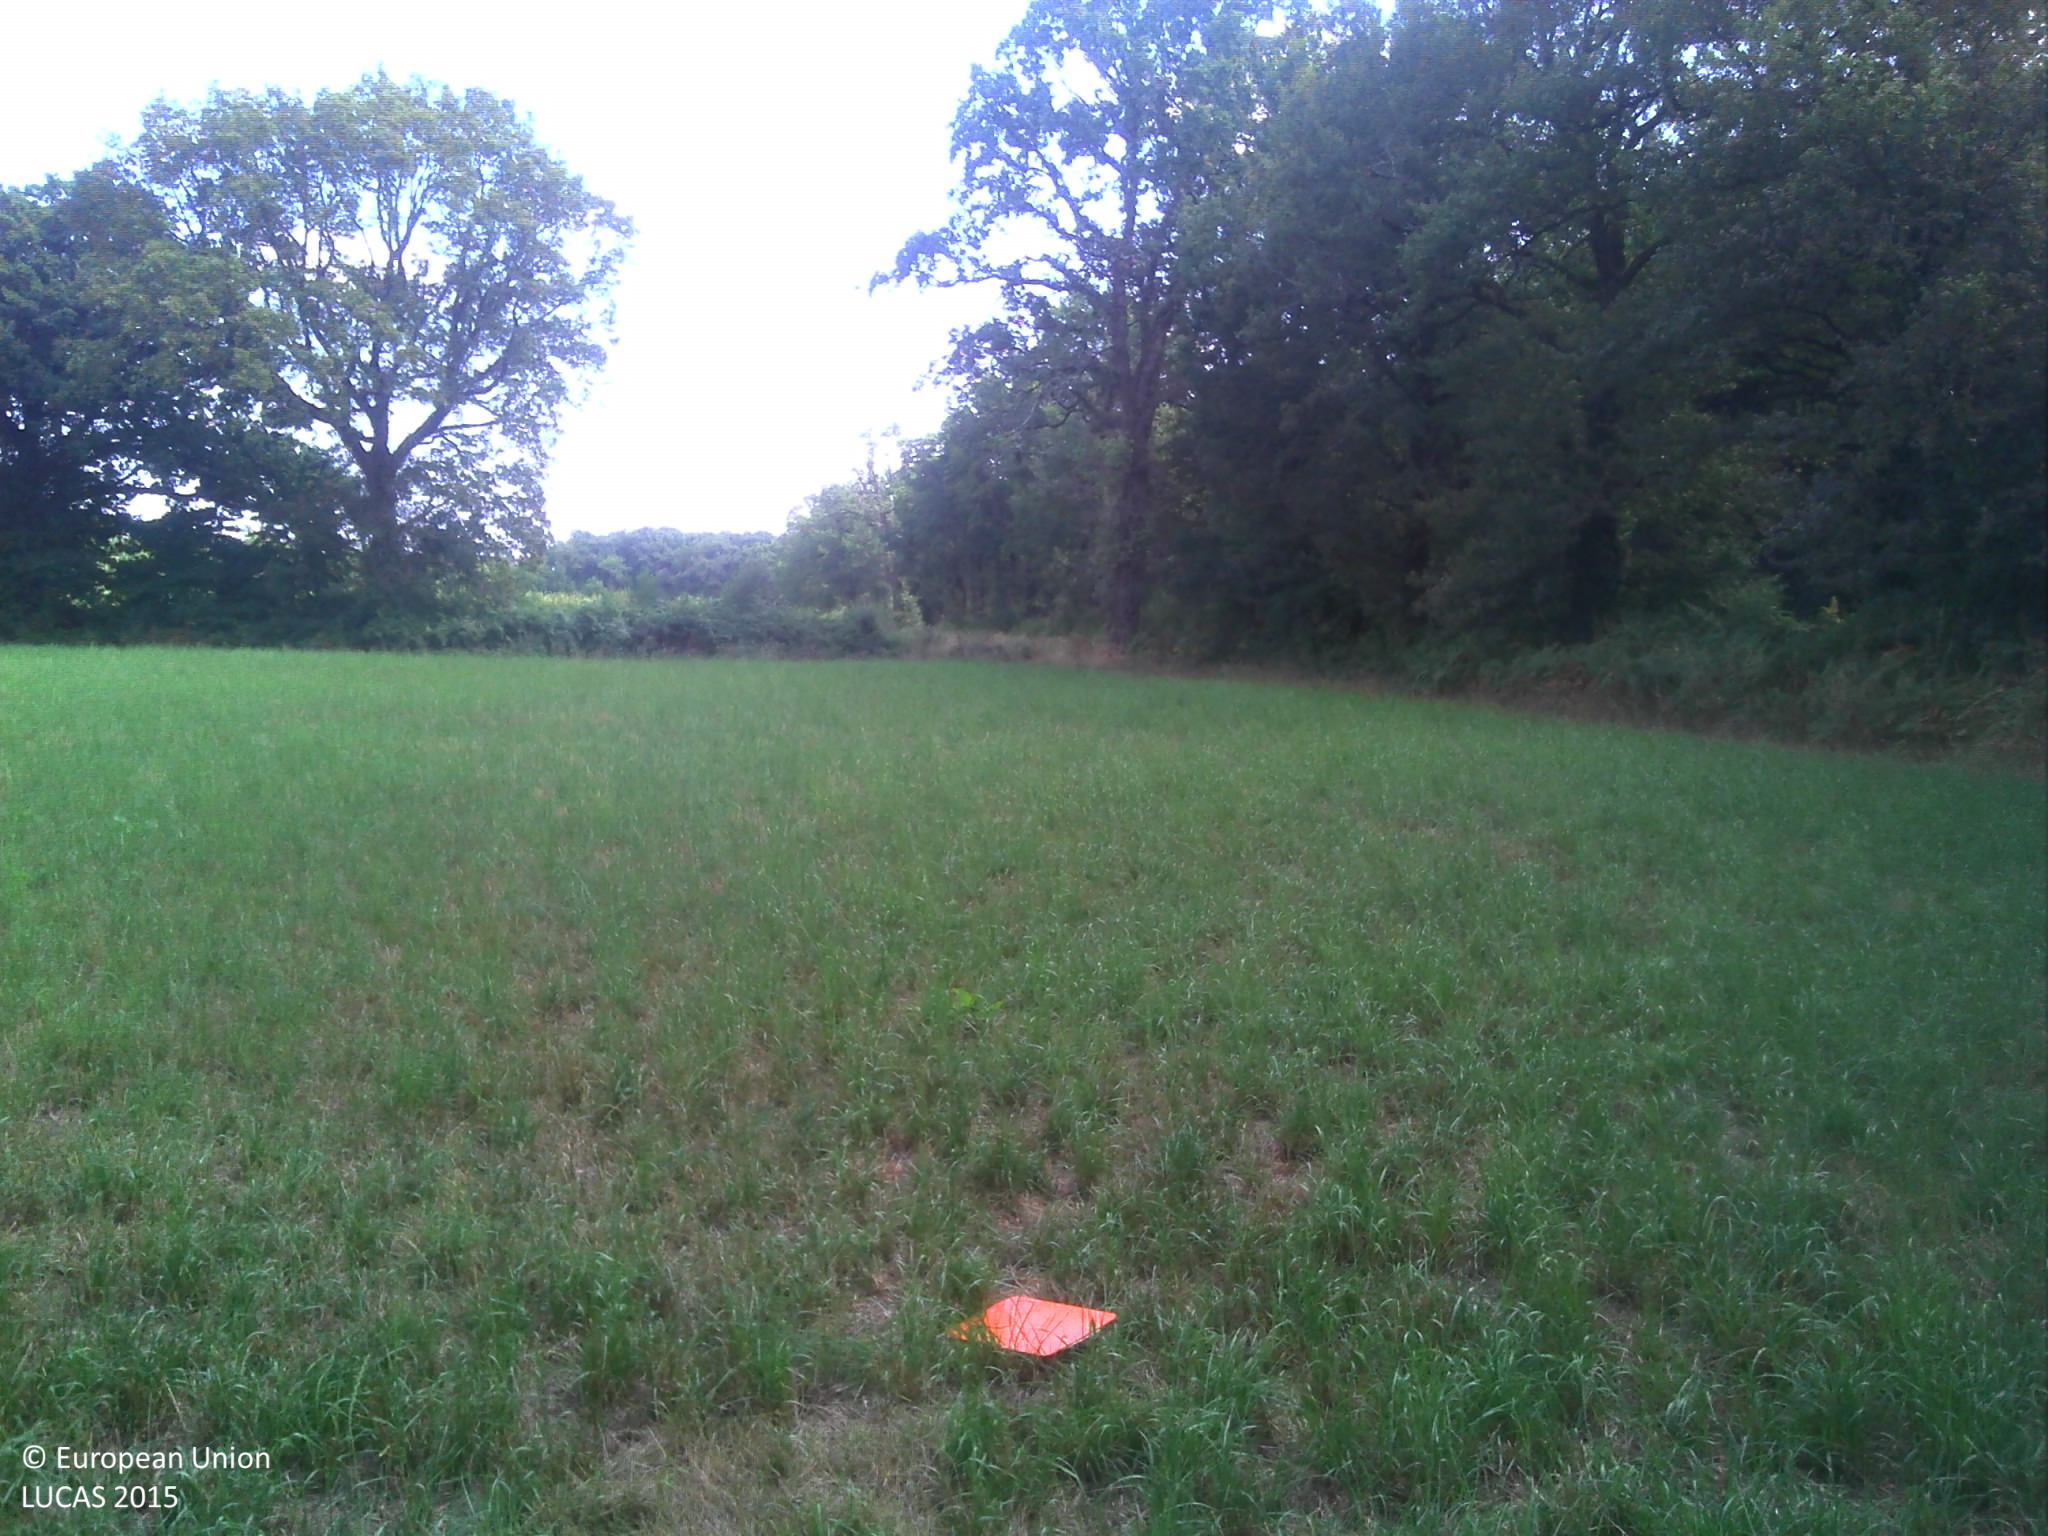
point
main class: Cropland
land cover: Temporary grasslands
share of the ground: > 75 %
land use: Agriculture (excluding fallow land and kitchen gardens)
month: July
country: FR
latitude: 46.4868
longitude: -1.3829
